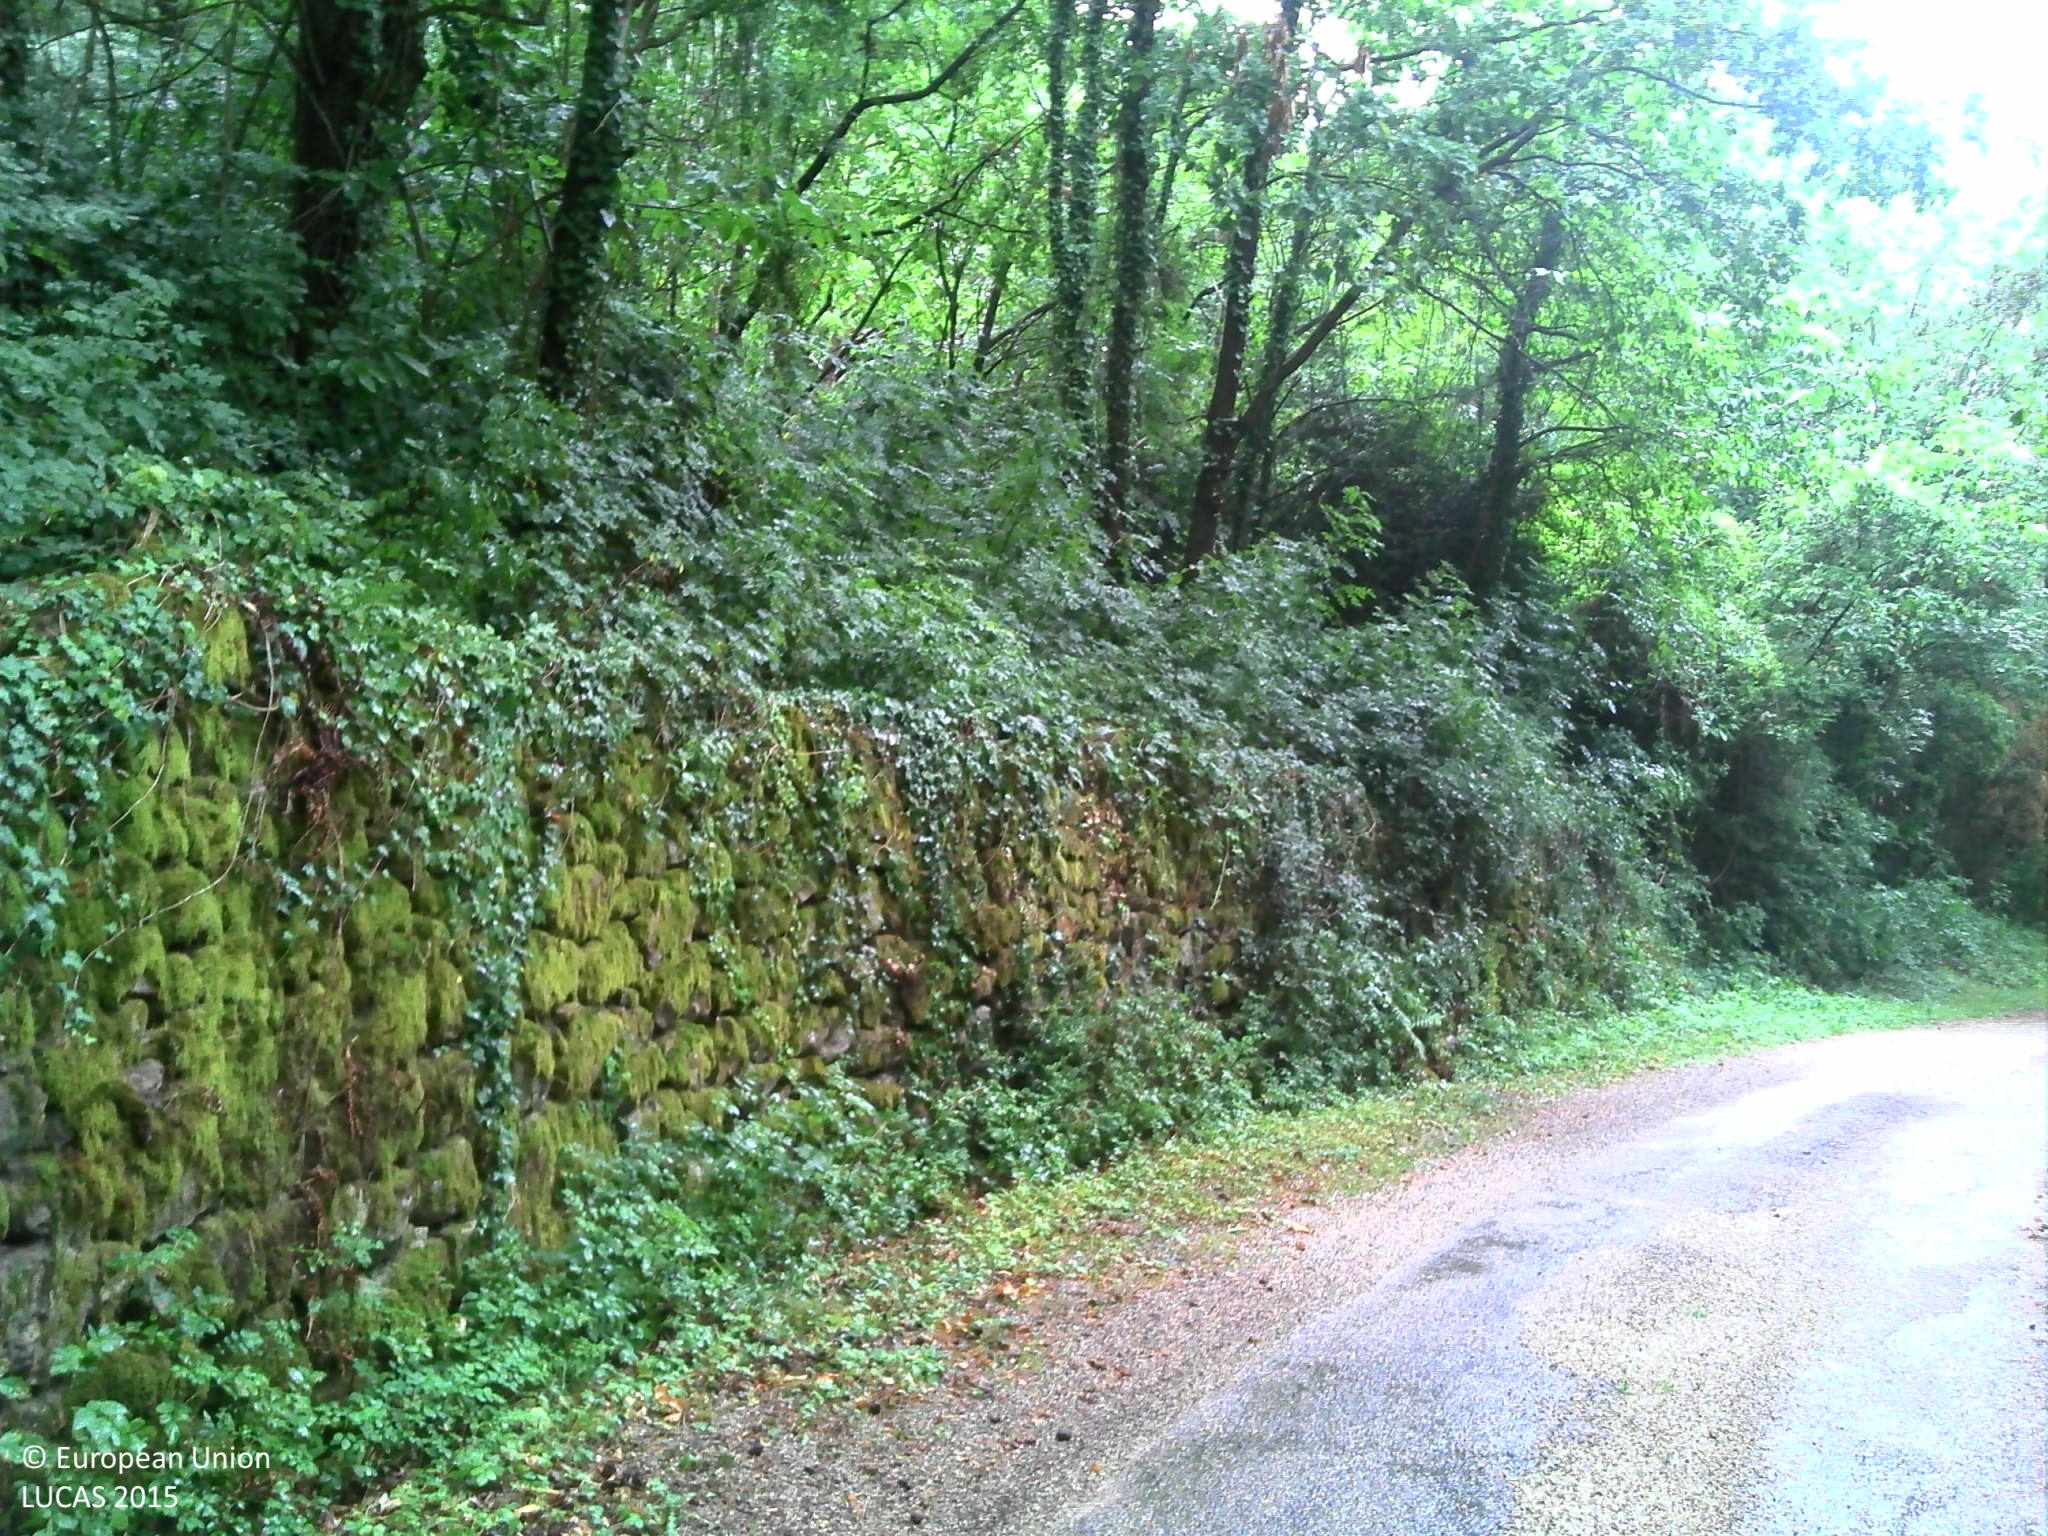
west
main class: Woodland
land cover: Pine dominated mixed woodland
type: mountainous beech forest
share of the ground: > 75 %
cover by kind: broadleaved forest trees 50 %, coniferous forest trees 25 %, herbaceous plants 25 %
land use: Semi-natural and natural areas not in use
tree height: > 5 m
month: July
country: FR
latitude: 44.7887
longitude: 4.6089
